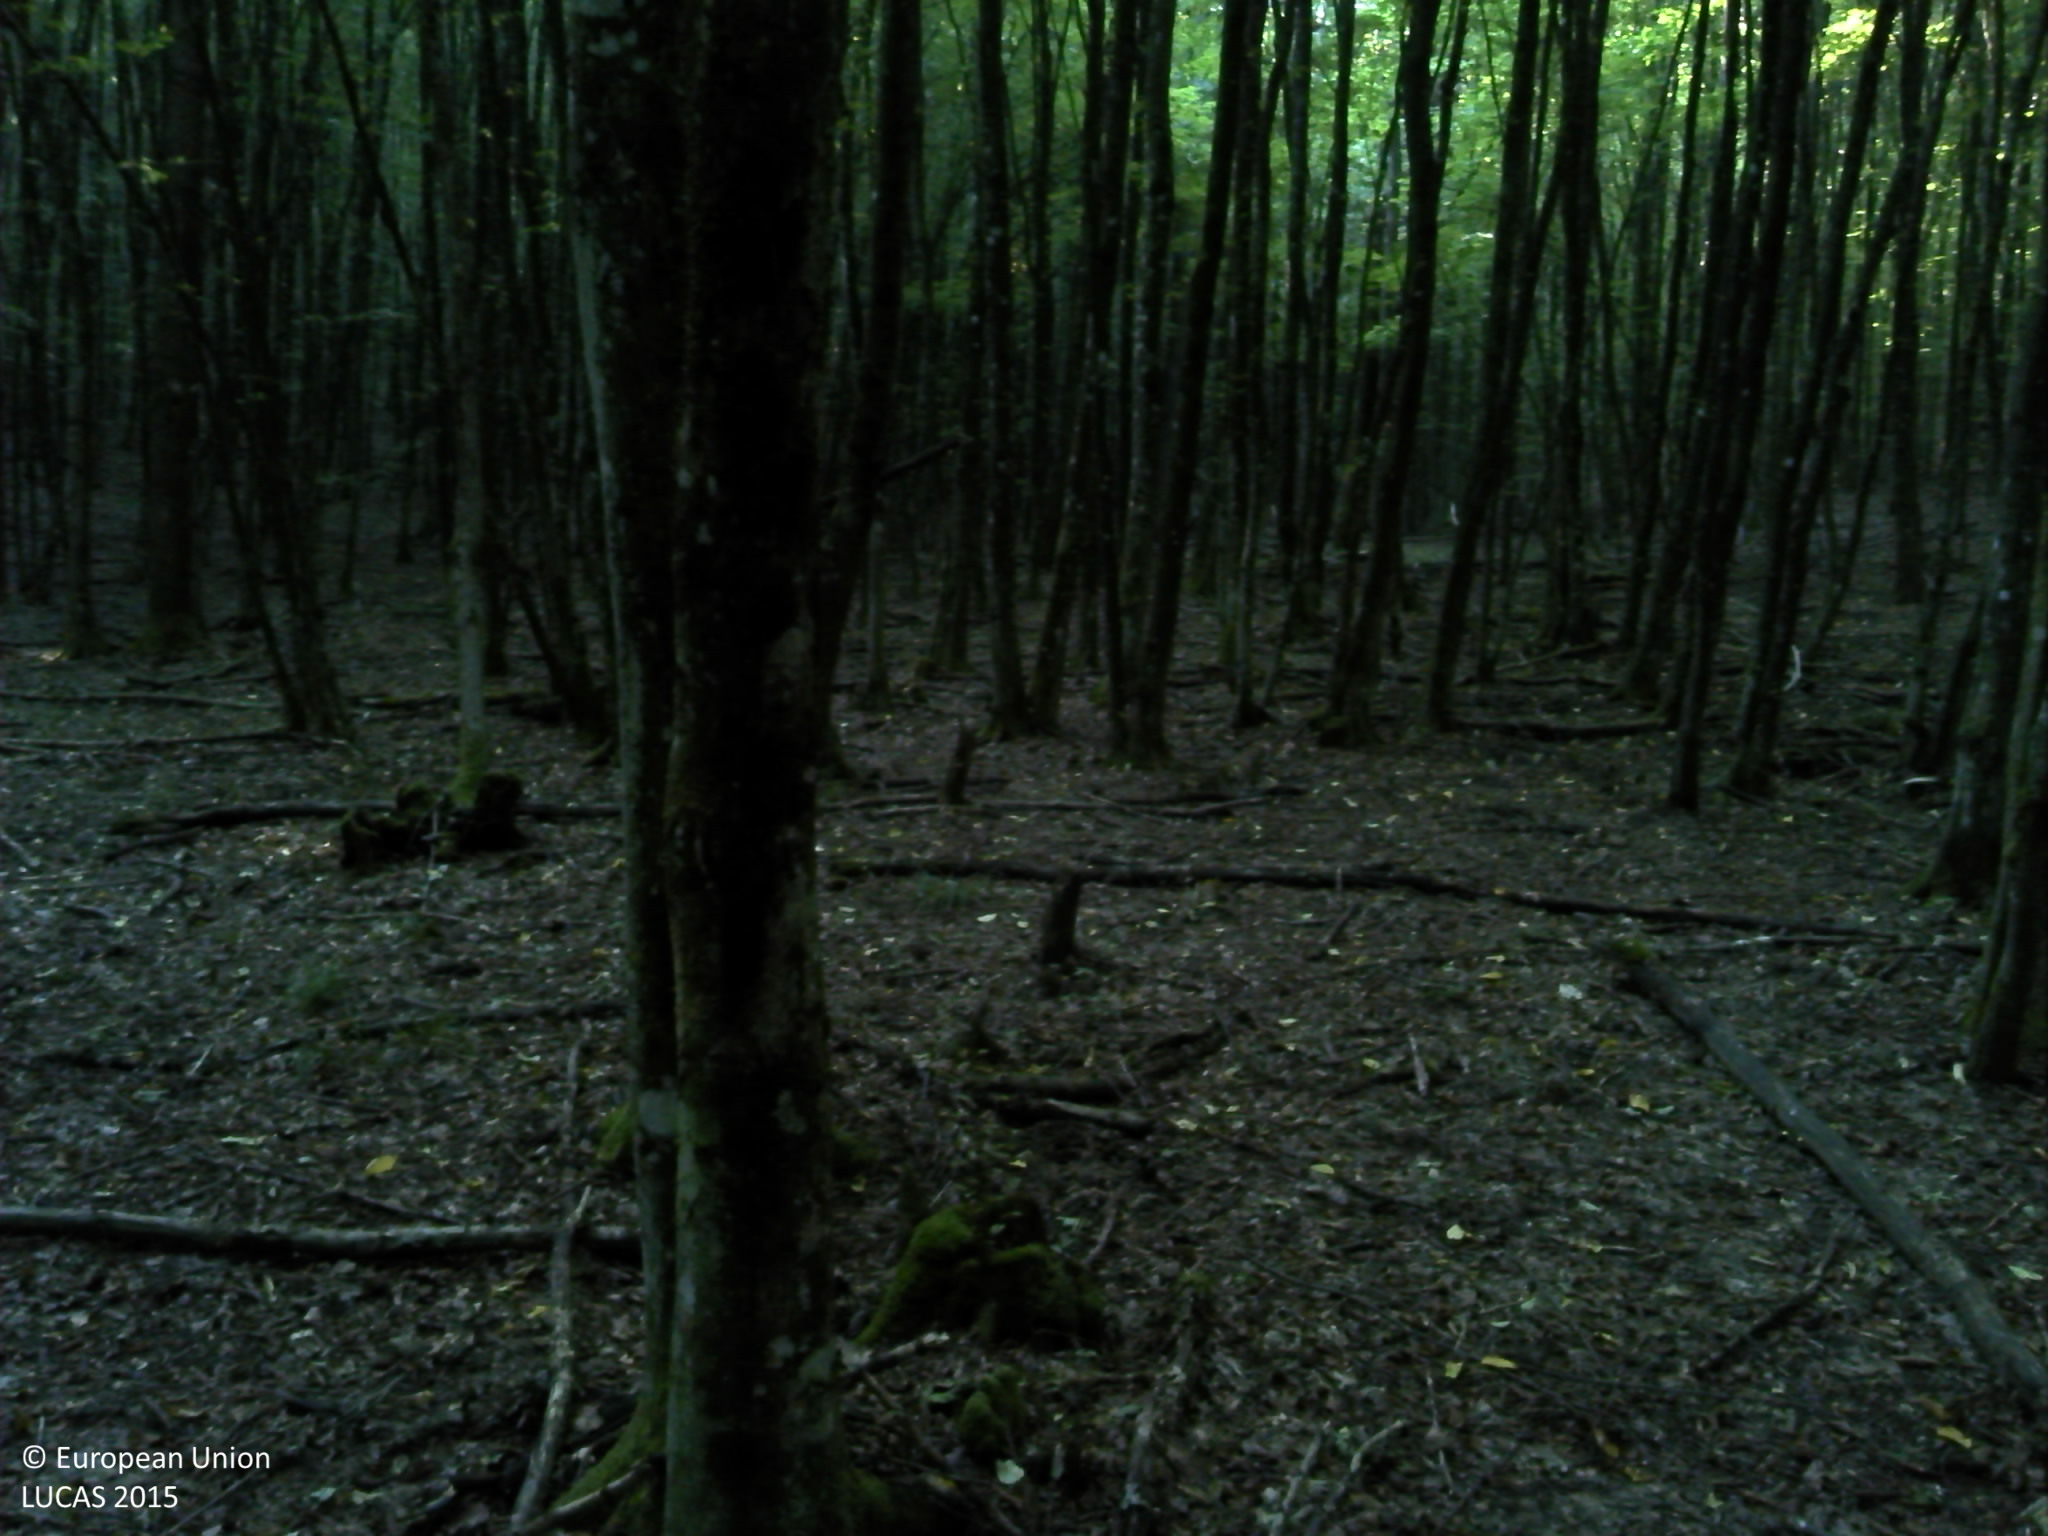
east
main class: Woodland
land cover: Broadleaved woodland
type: beech forest
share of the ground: > 75 %
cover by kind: broadleaved forest trees 100 %
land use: Forestry
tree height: > 5 m
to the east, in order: Broadleaved woodland
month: August
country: HR
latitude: 45.7048
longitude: 17.2841
